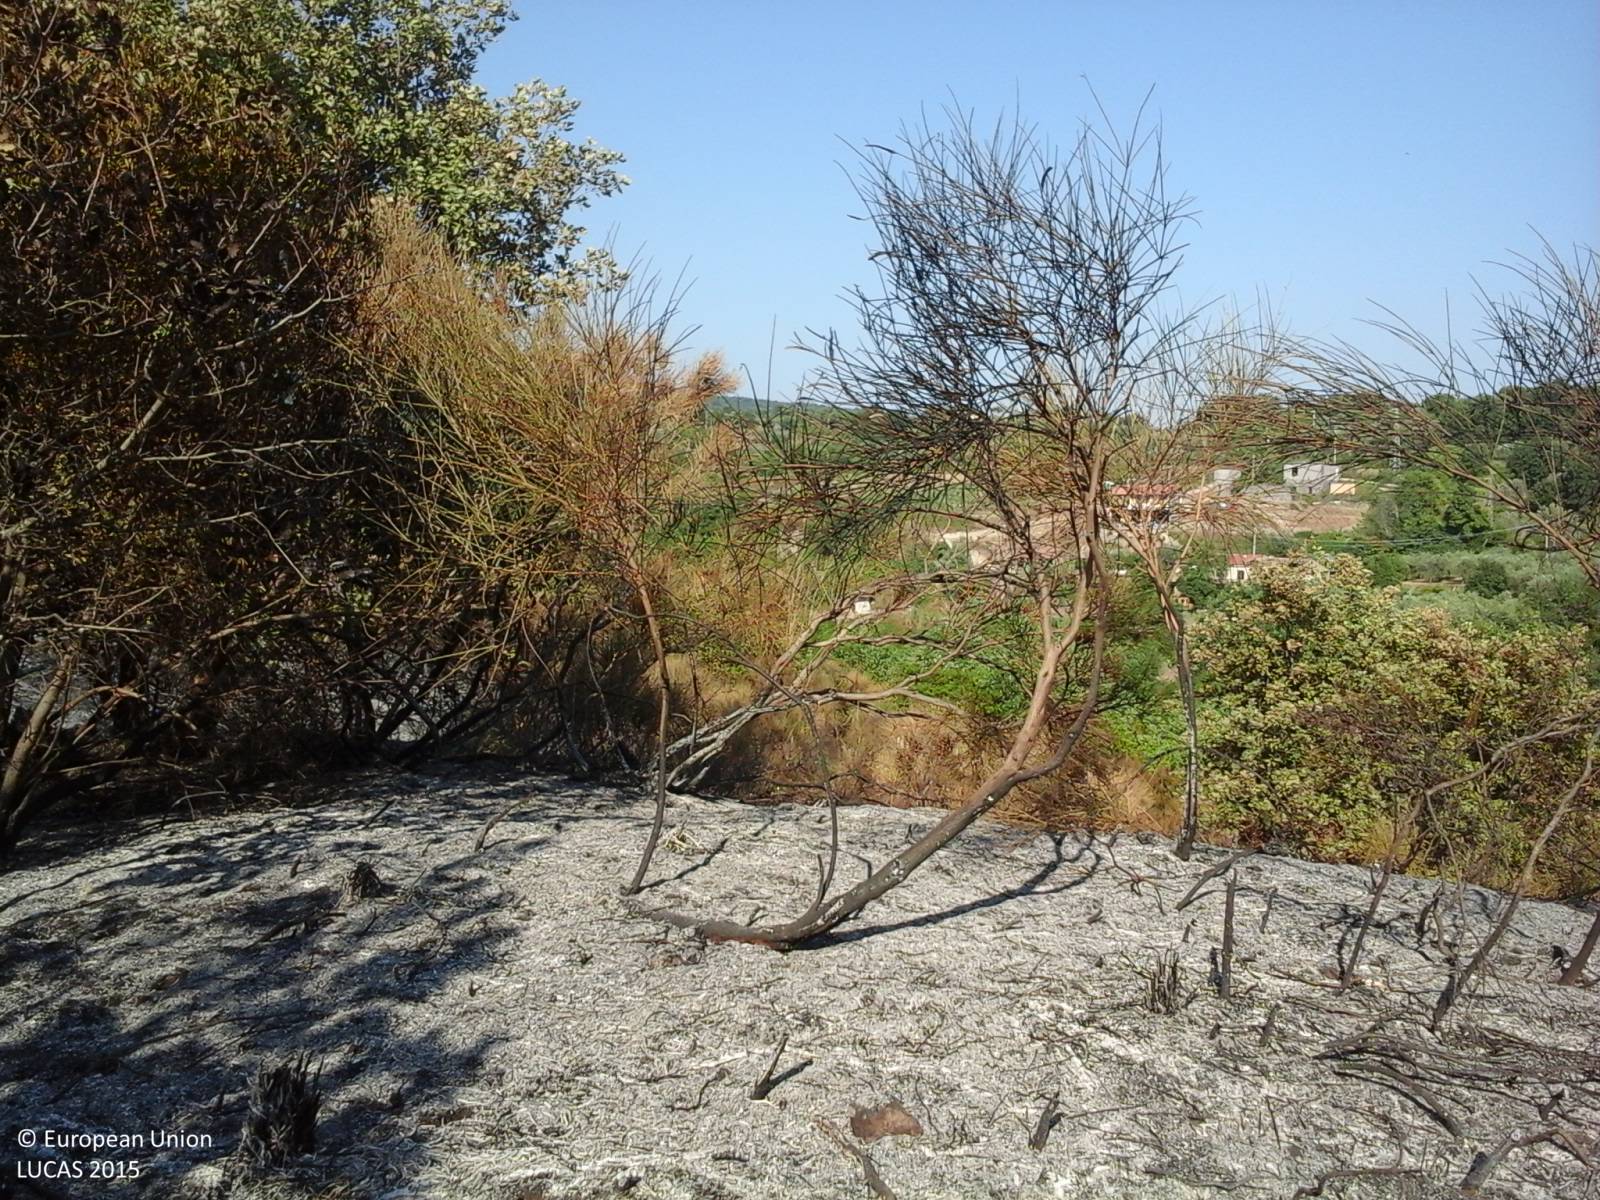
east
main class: Shrubland
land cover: Shrubland with sparse tree cover
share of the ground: 50 - 75 %
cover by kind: shrubs 95 %, broadleaved forest trees 5 %
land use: Abandoned areas
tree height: < 5 m
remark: Burnt area
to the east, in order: Shrubland with sparse tree cover; Broadleaved woodland
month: July
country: IT
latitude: 41.2570
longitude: 13.9350
